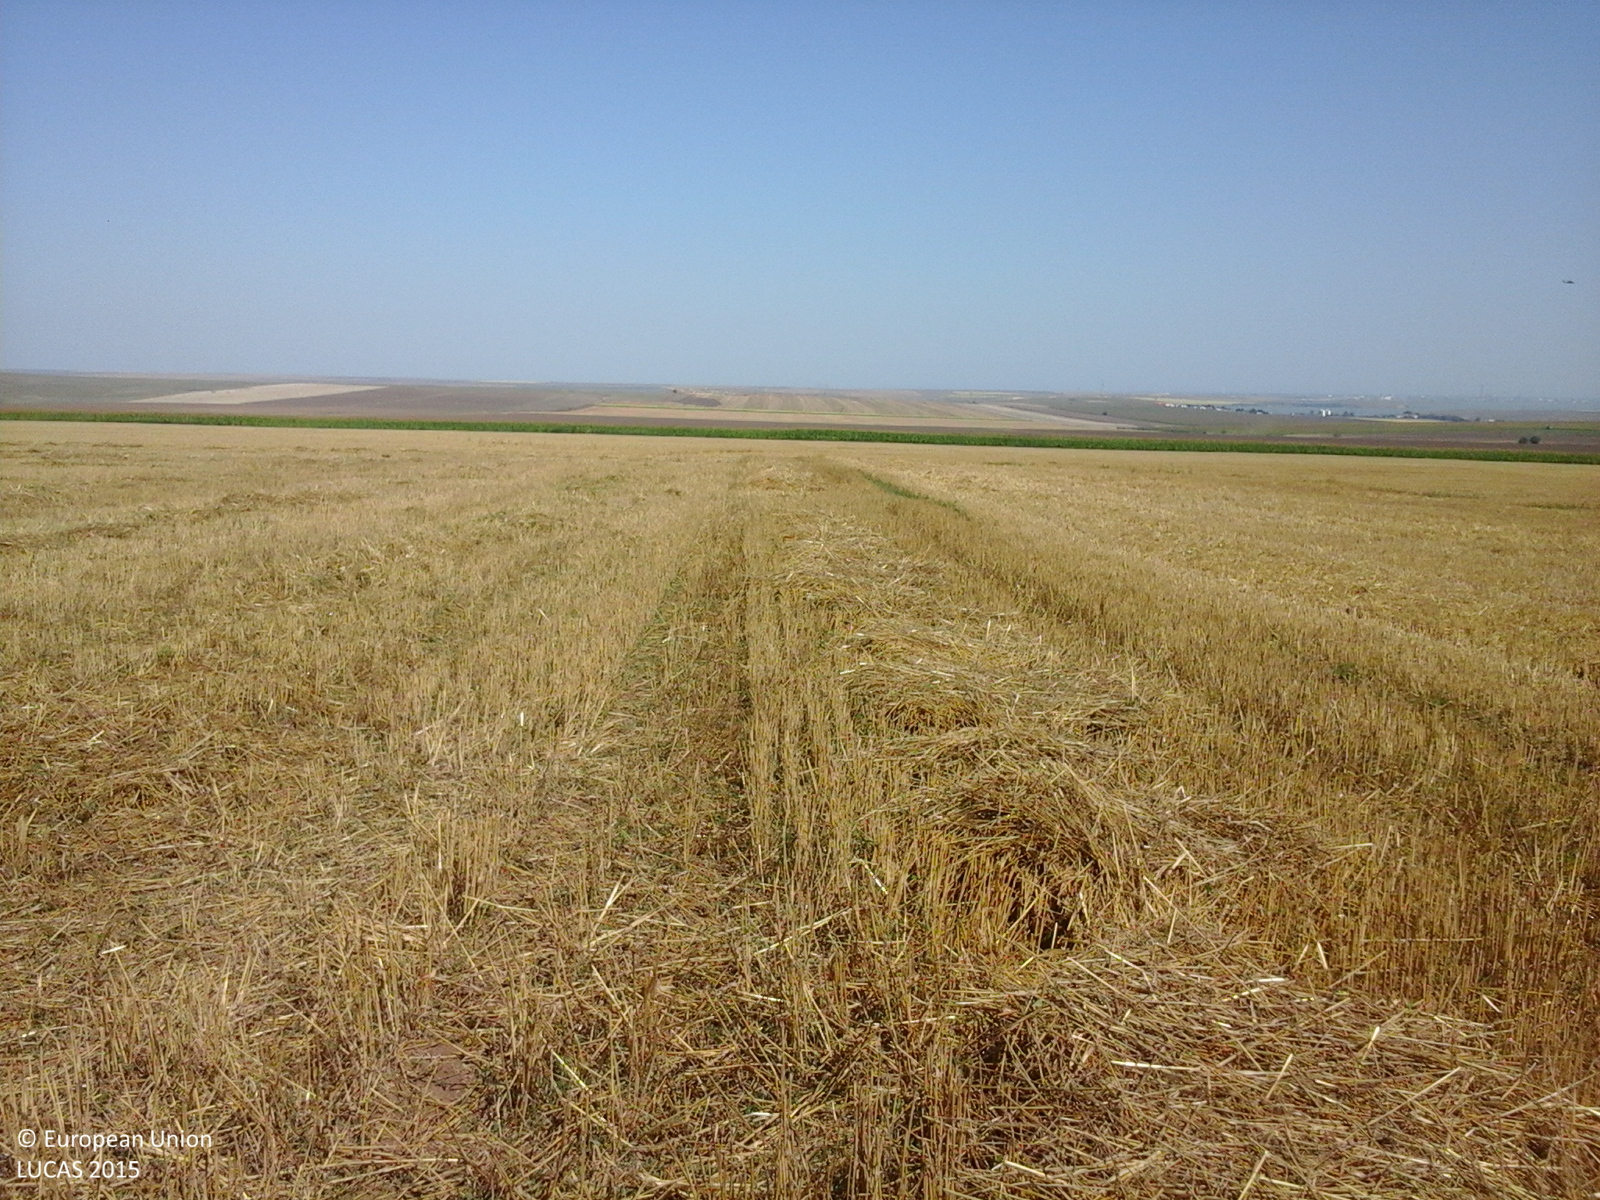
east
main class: Cropland
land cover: Common wheat
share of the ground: 25 - 50 %
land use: Agriculture (excluding fallow land and kitchen gardens)
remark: Harvested field
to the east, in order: Common wheat; Maize
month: August
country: RO
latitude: 44.4108
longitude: 28.4684
